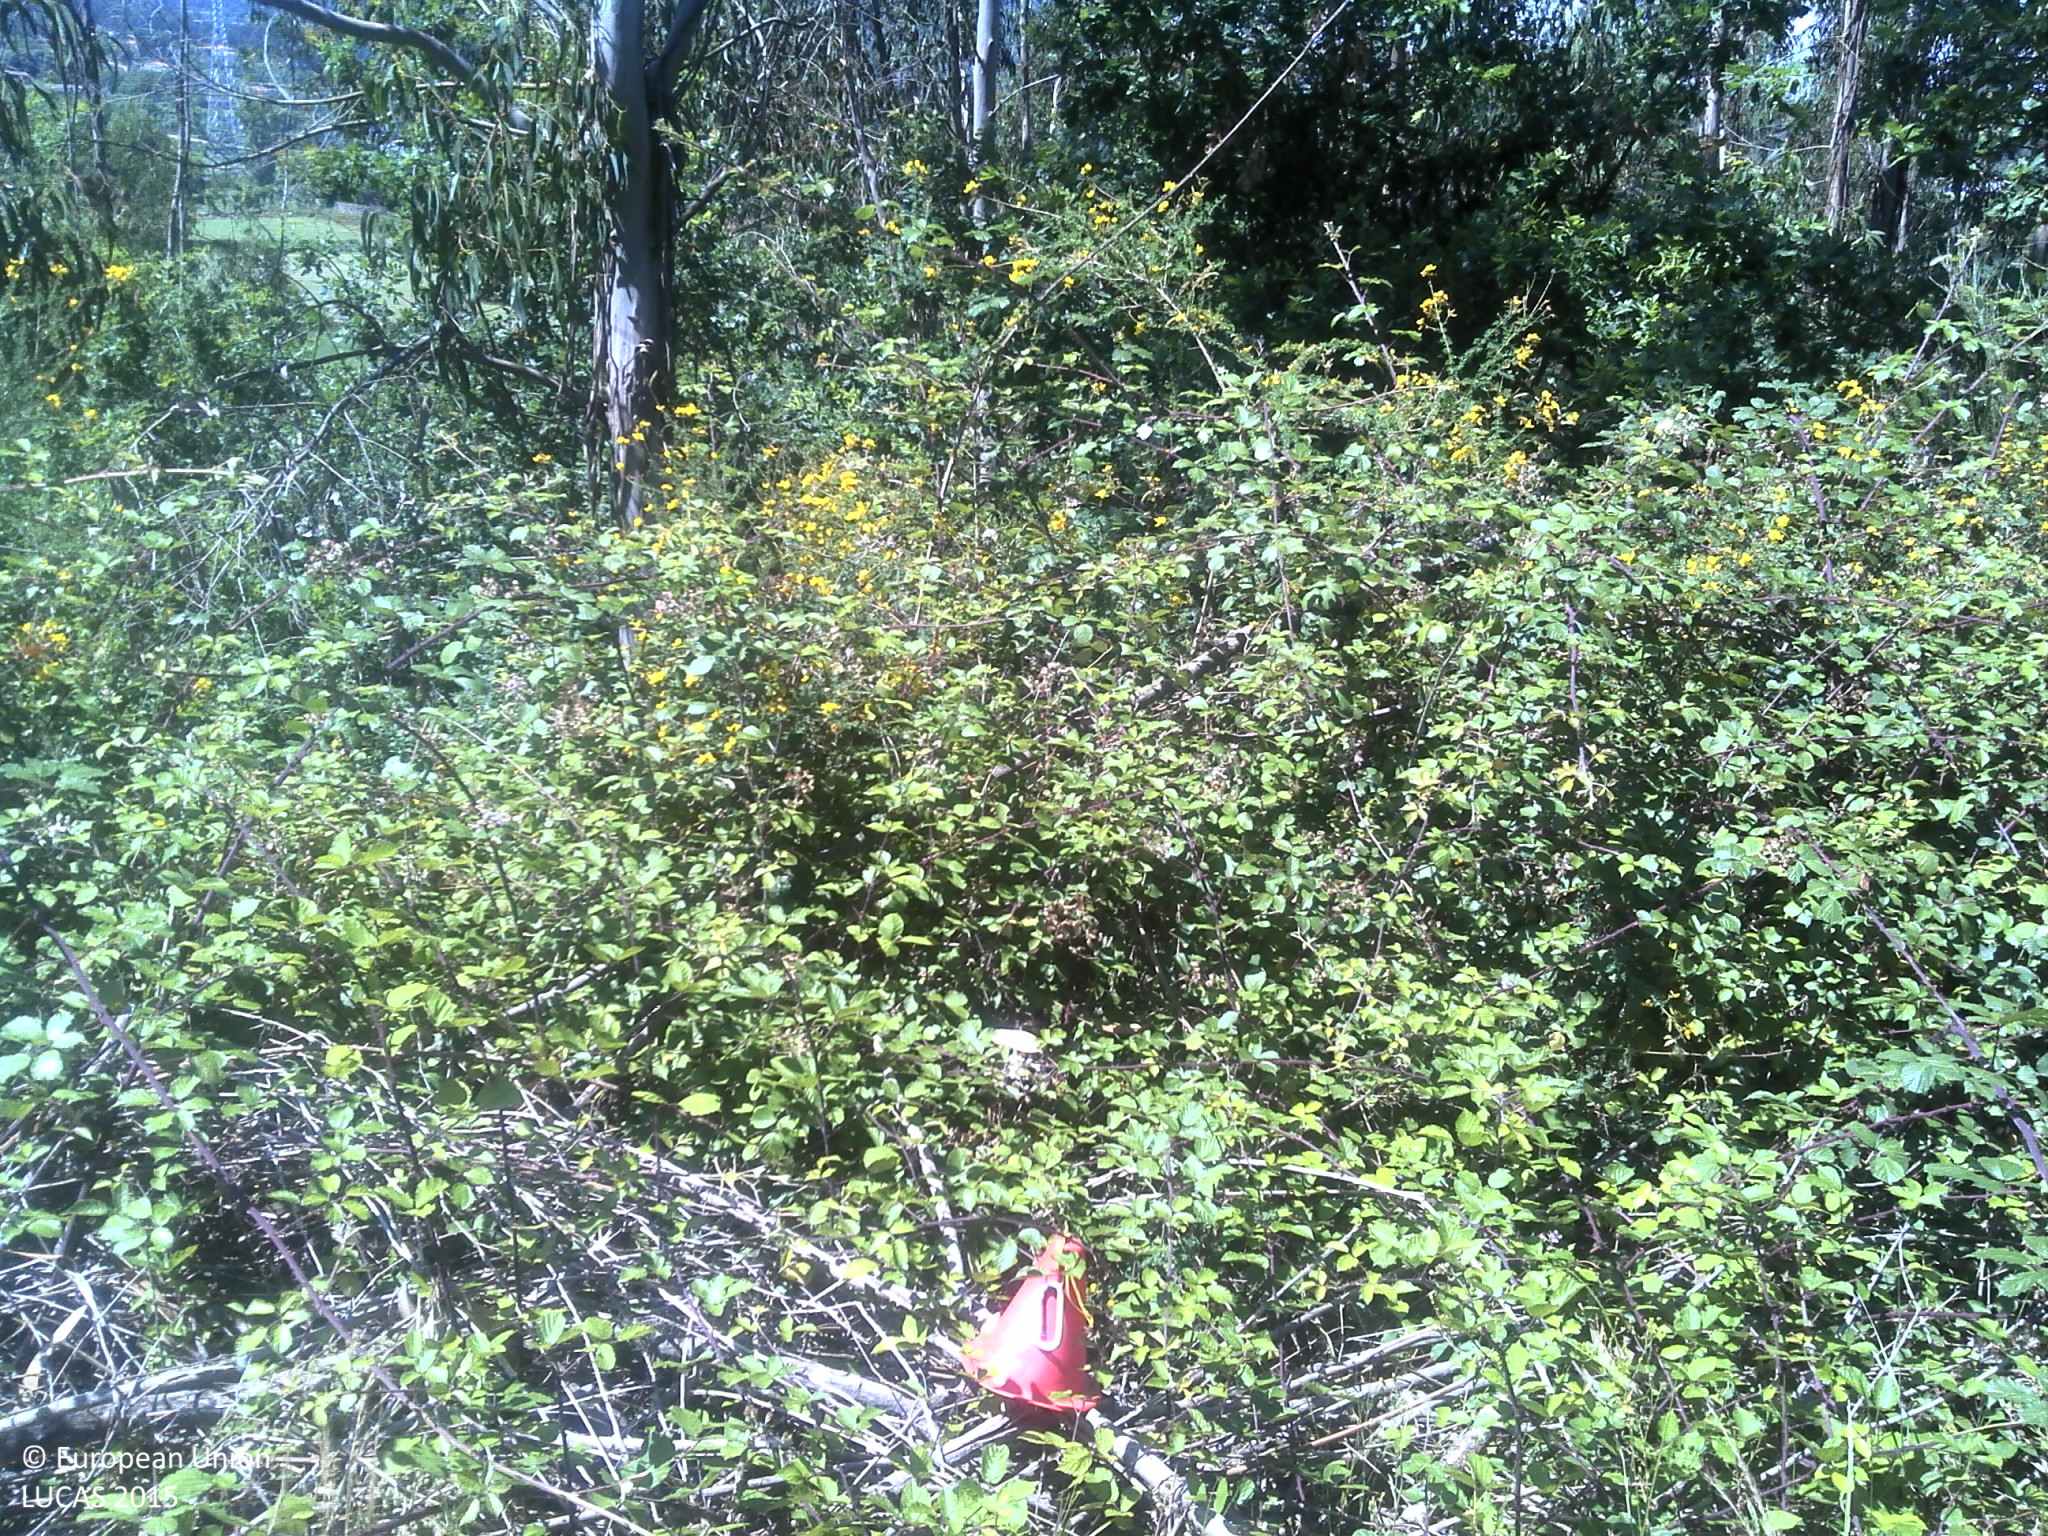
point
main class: Shrubland
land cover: Shrubland with sparse tree cover
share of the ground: > 75 %
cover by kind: shrubs 85 %, unconsolidated bare surface 10 %, broadleaved forest trees 5 %
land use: Semi-natural and natural areas not in use
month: June
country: PT
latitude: 41.5274
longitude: -8.2819
